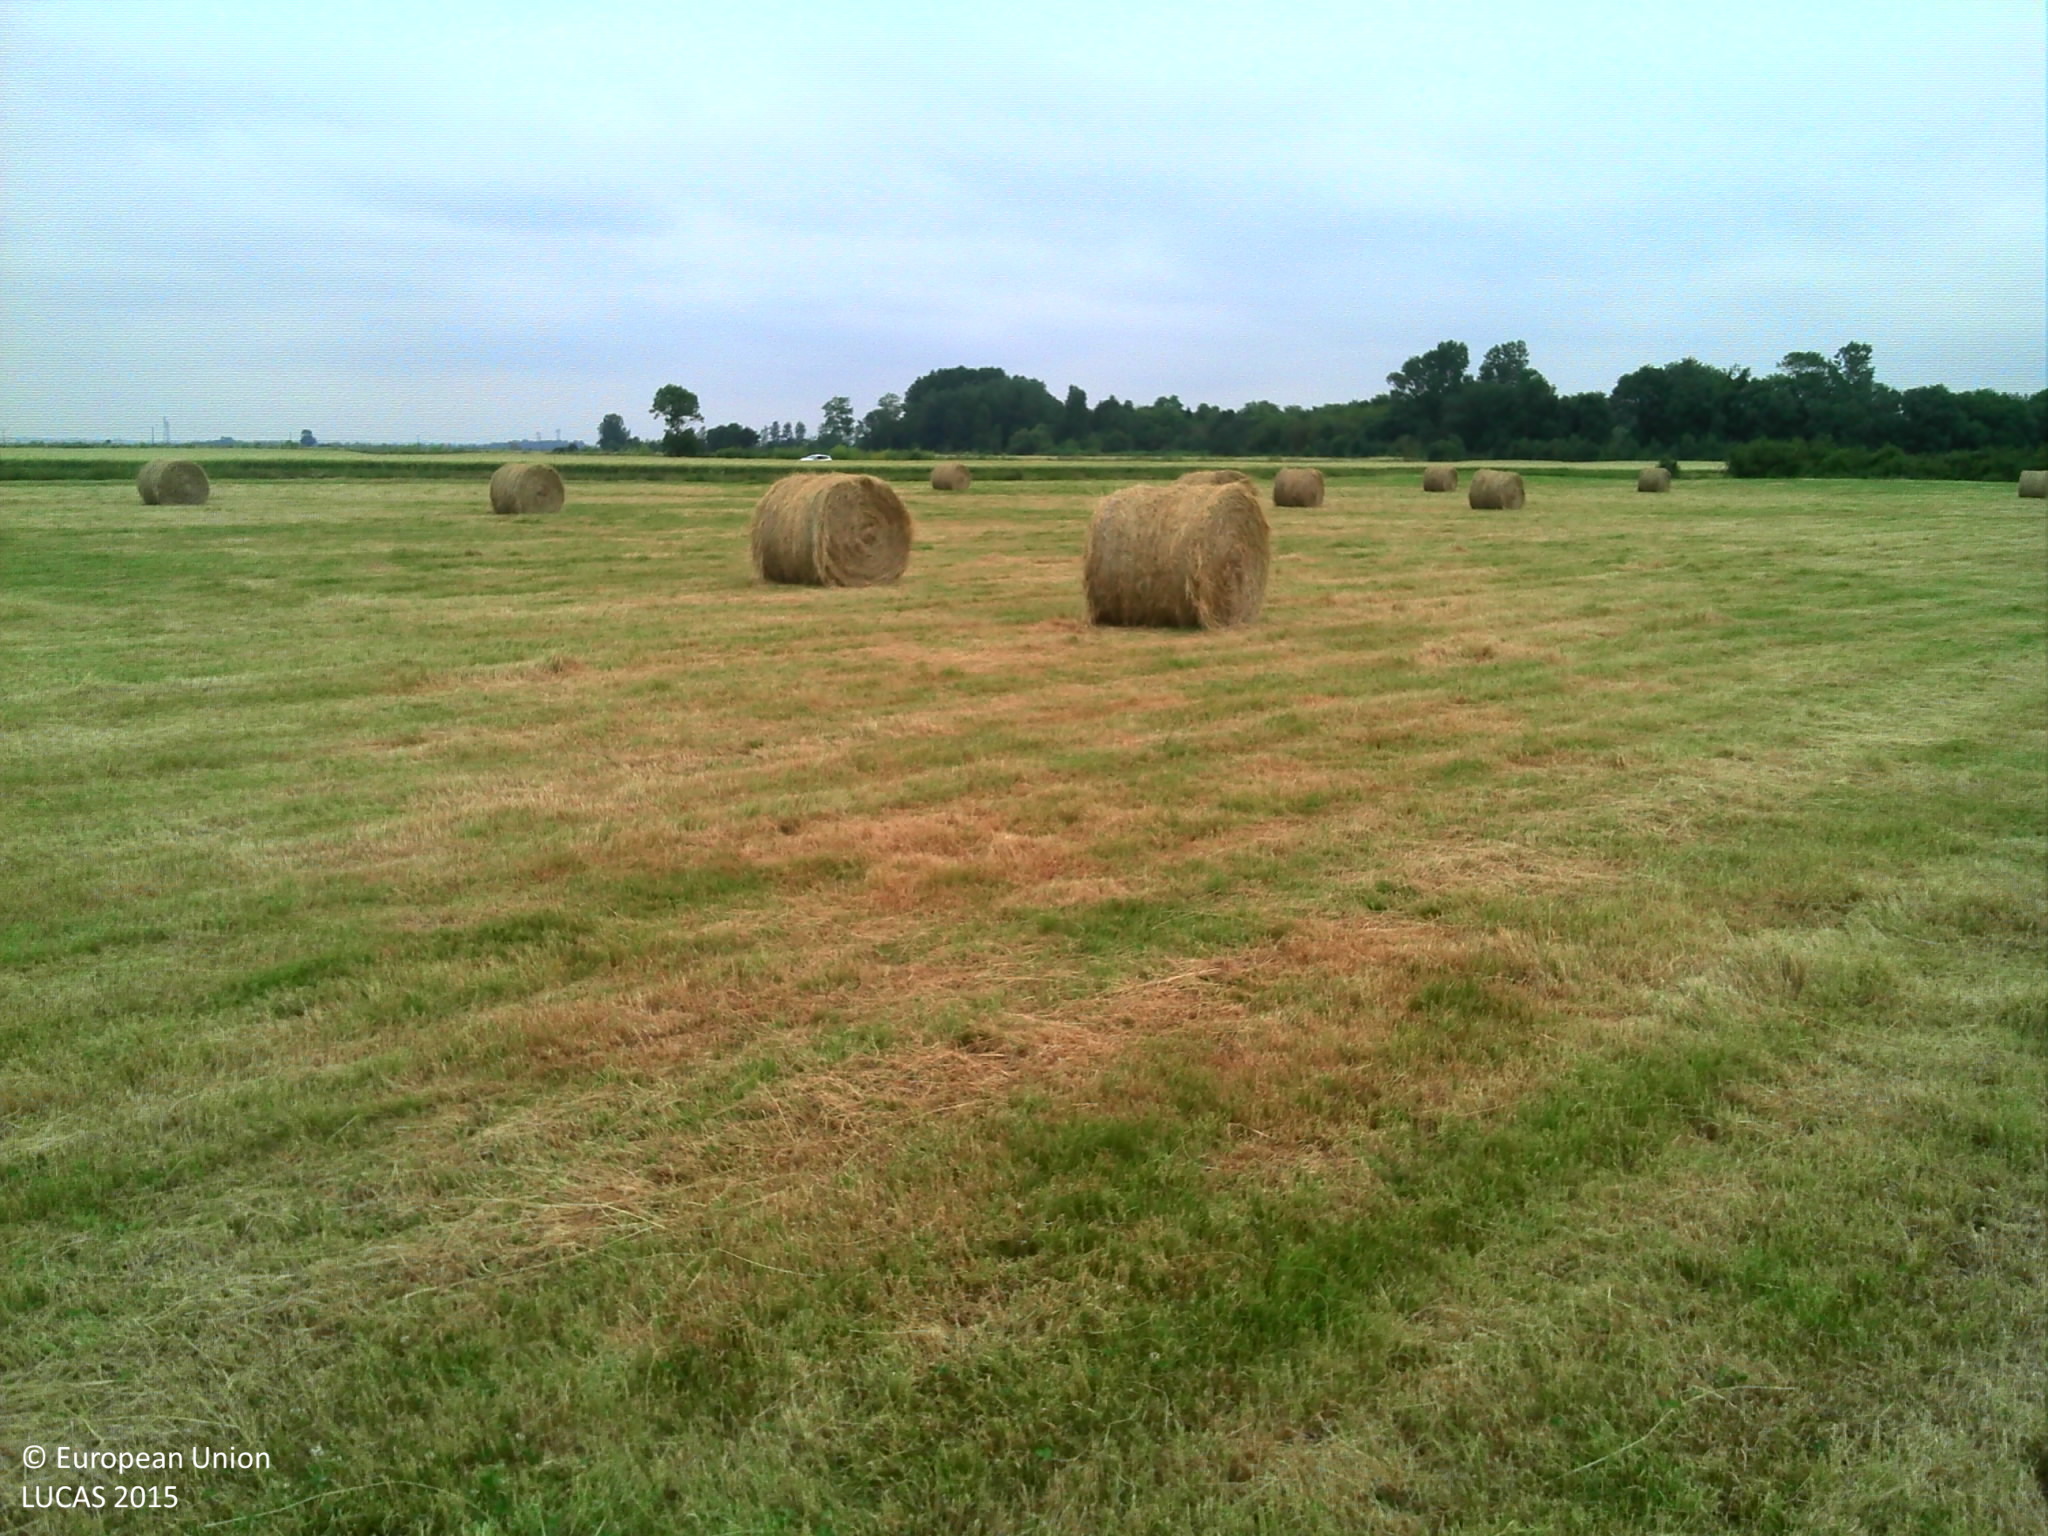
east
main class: Grassland
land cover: Grassland without tree/shrub cover
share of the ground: > 75 %
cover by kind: herbaceous plants 100 %
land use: Agriculture (excluding fallow land and kitchen gardens)
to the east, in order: Grassland without tree/shrub cover; Inland fresh running water; Grassland without tree/shrub cover; Durum wheat; Tracks; Durum wheat
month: June
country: FR
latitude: 45.9733
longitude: -0.9081
